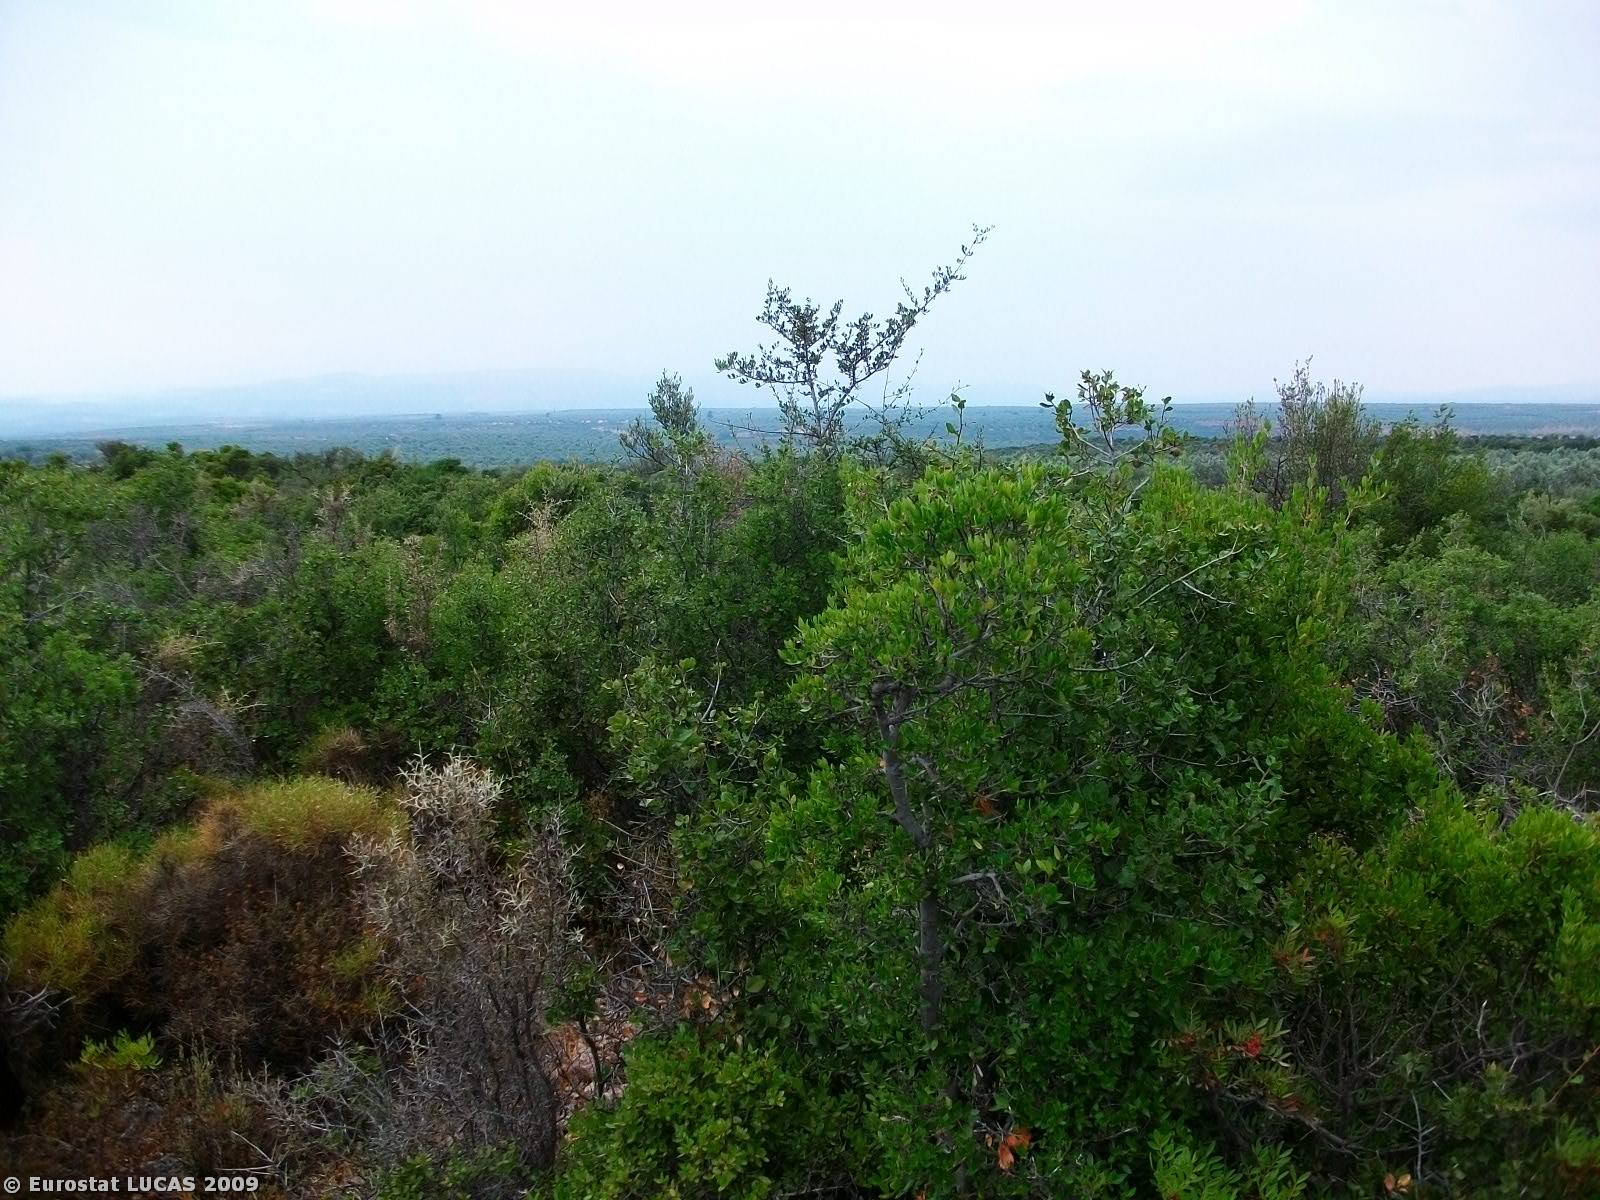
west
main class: Shrubland
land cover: Shrubland without tree cover
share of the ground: > 75 %
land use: Unused
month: August
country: GR
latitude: 36.9412
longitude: 22.7452
